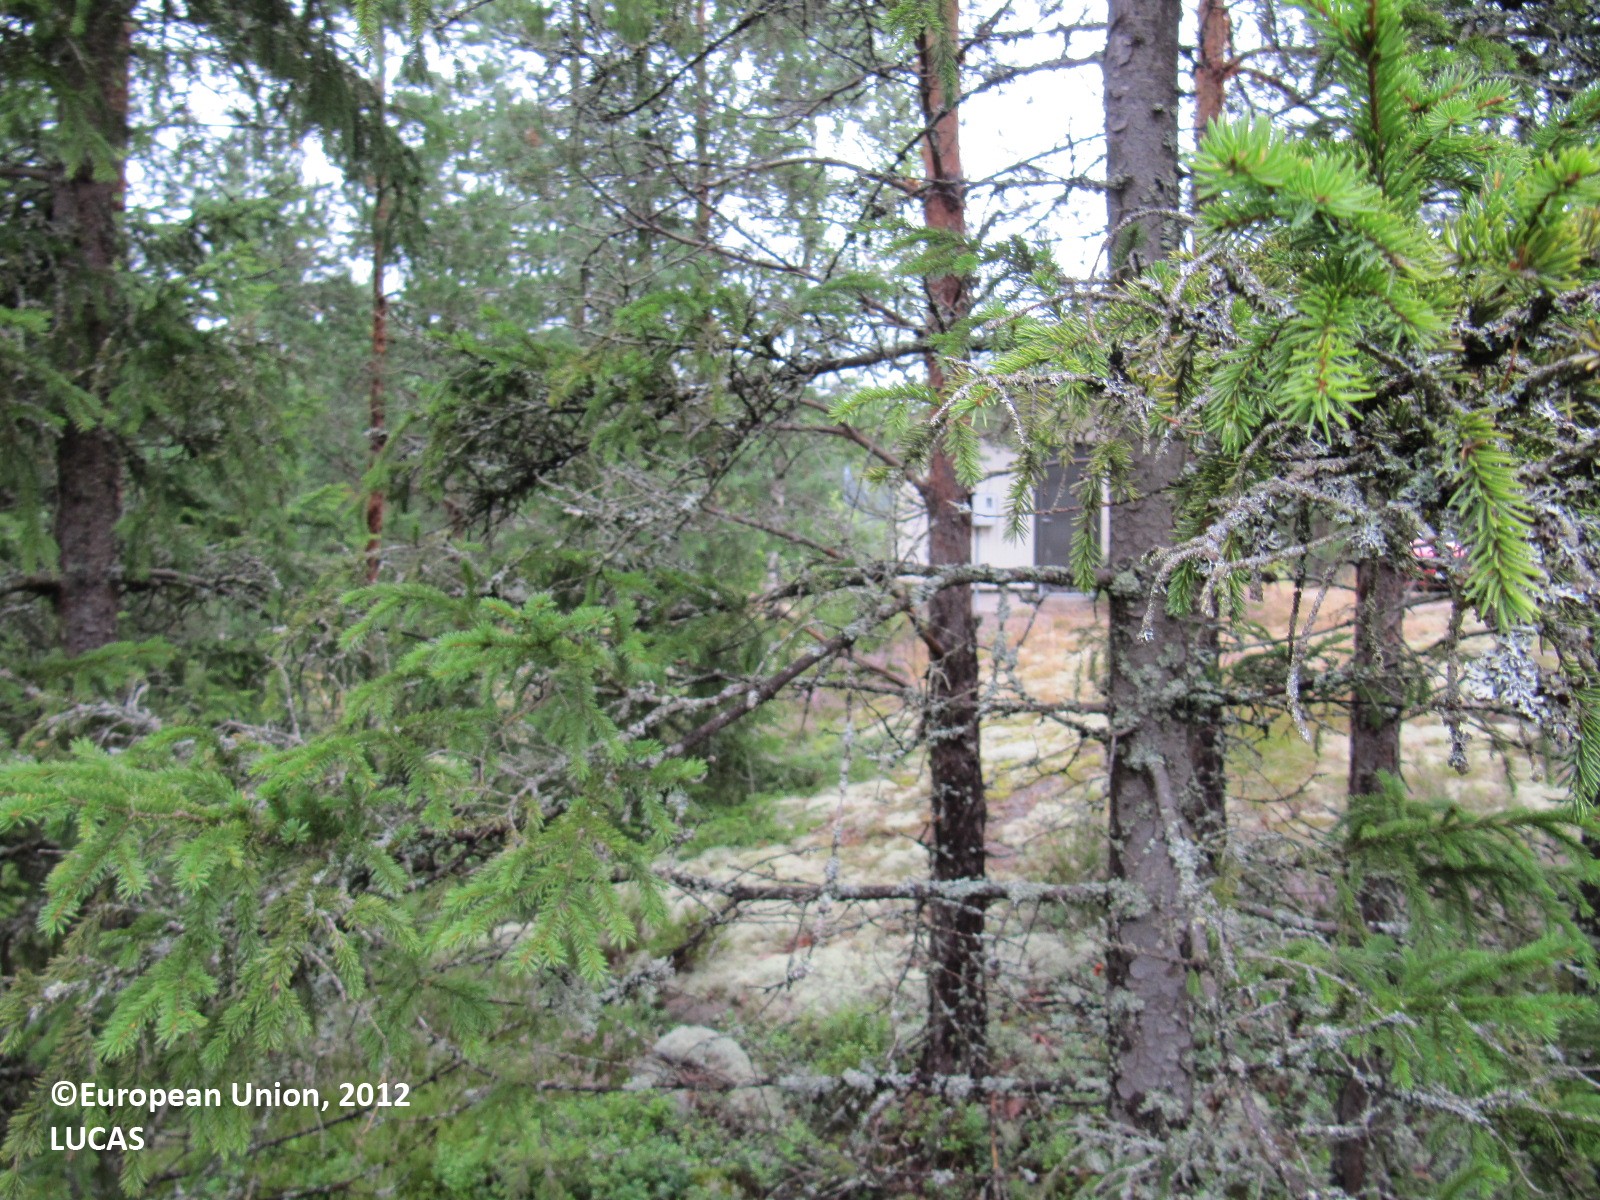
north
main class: Woodland
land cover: Pine dominated coniferous woodland
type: boreal forest
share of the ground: 50 - 75 %
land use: Forestry
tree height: > 5 m
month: August
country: FI
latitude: 60.2843
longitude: 23.0476
